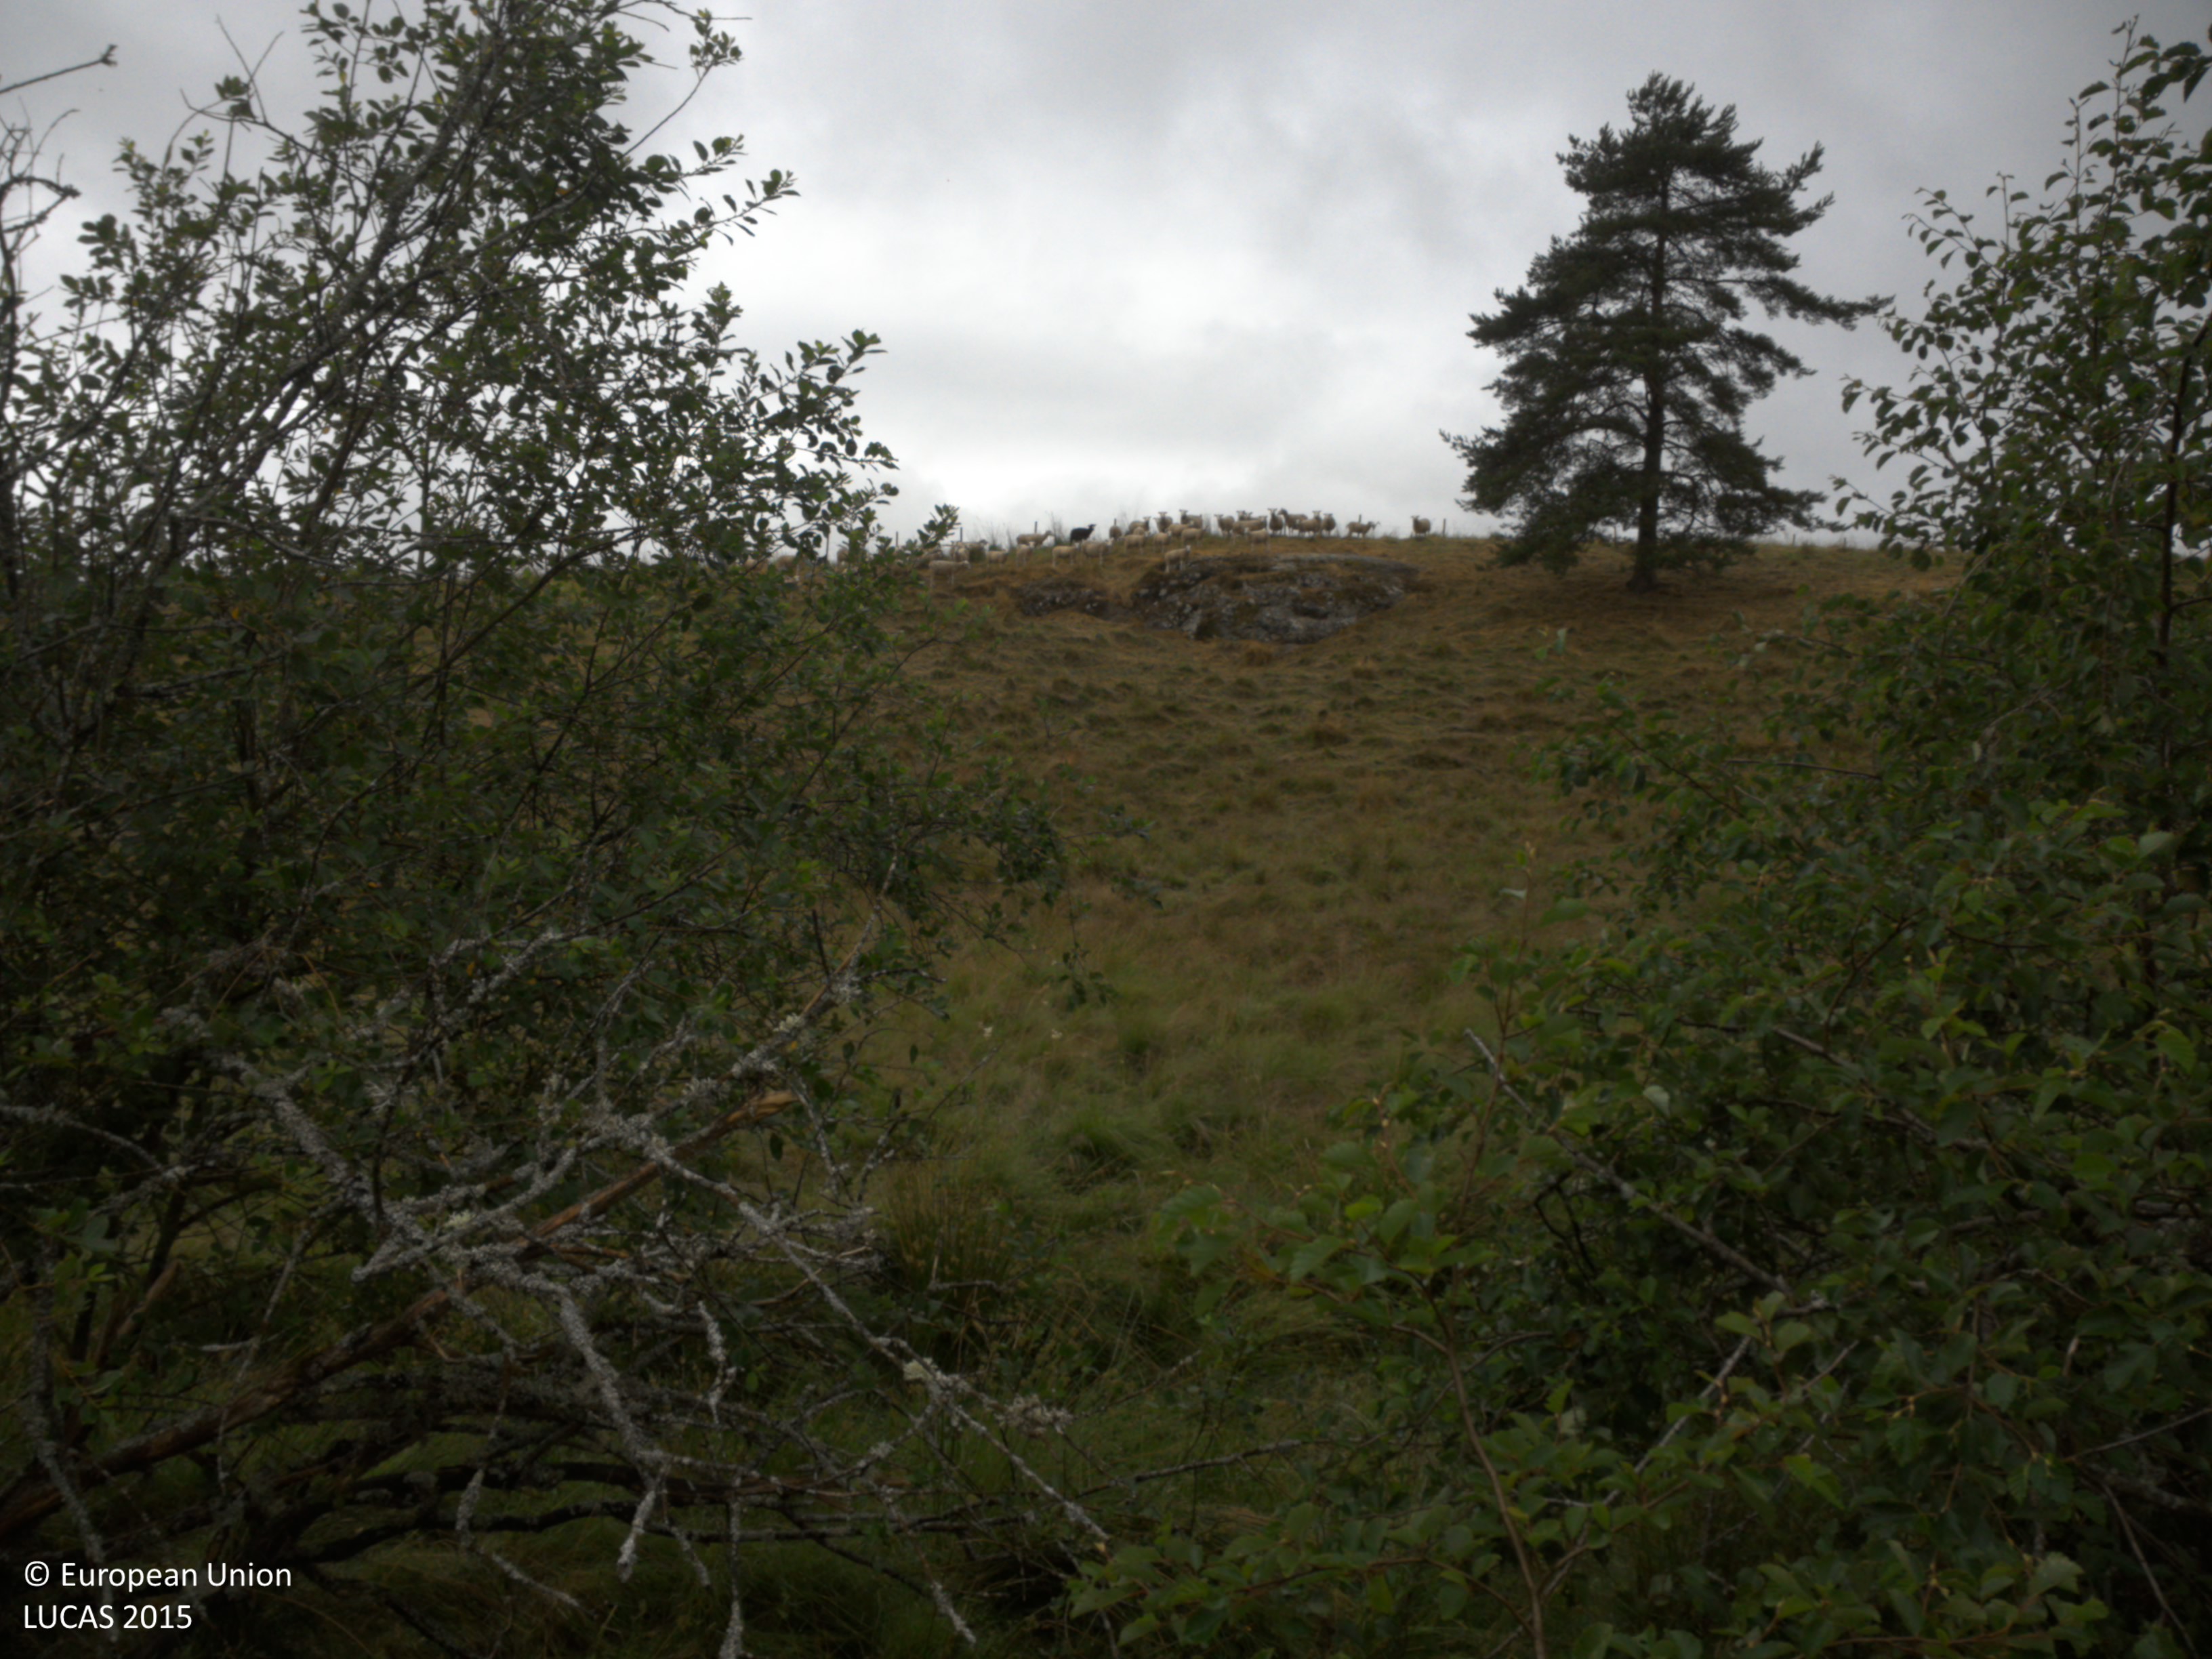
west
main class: Grassland
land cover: Grassland with sparse tree/shrub cover
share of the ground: > 75 %
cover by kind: herbaceous plants 95 %, coniferous forest trees 5 %
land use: Agriculture (excluding fallow land and kitchen gardens)
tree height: < 5 m
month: July
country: SE
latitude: 58.7291
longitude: 11.8095
